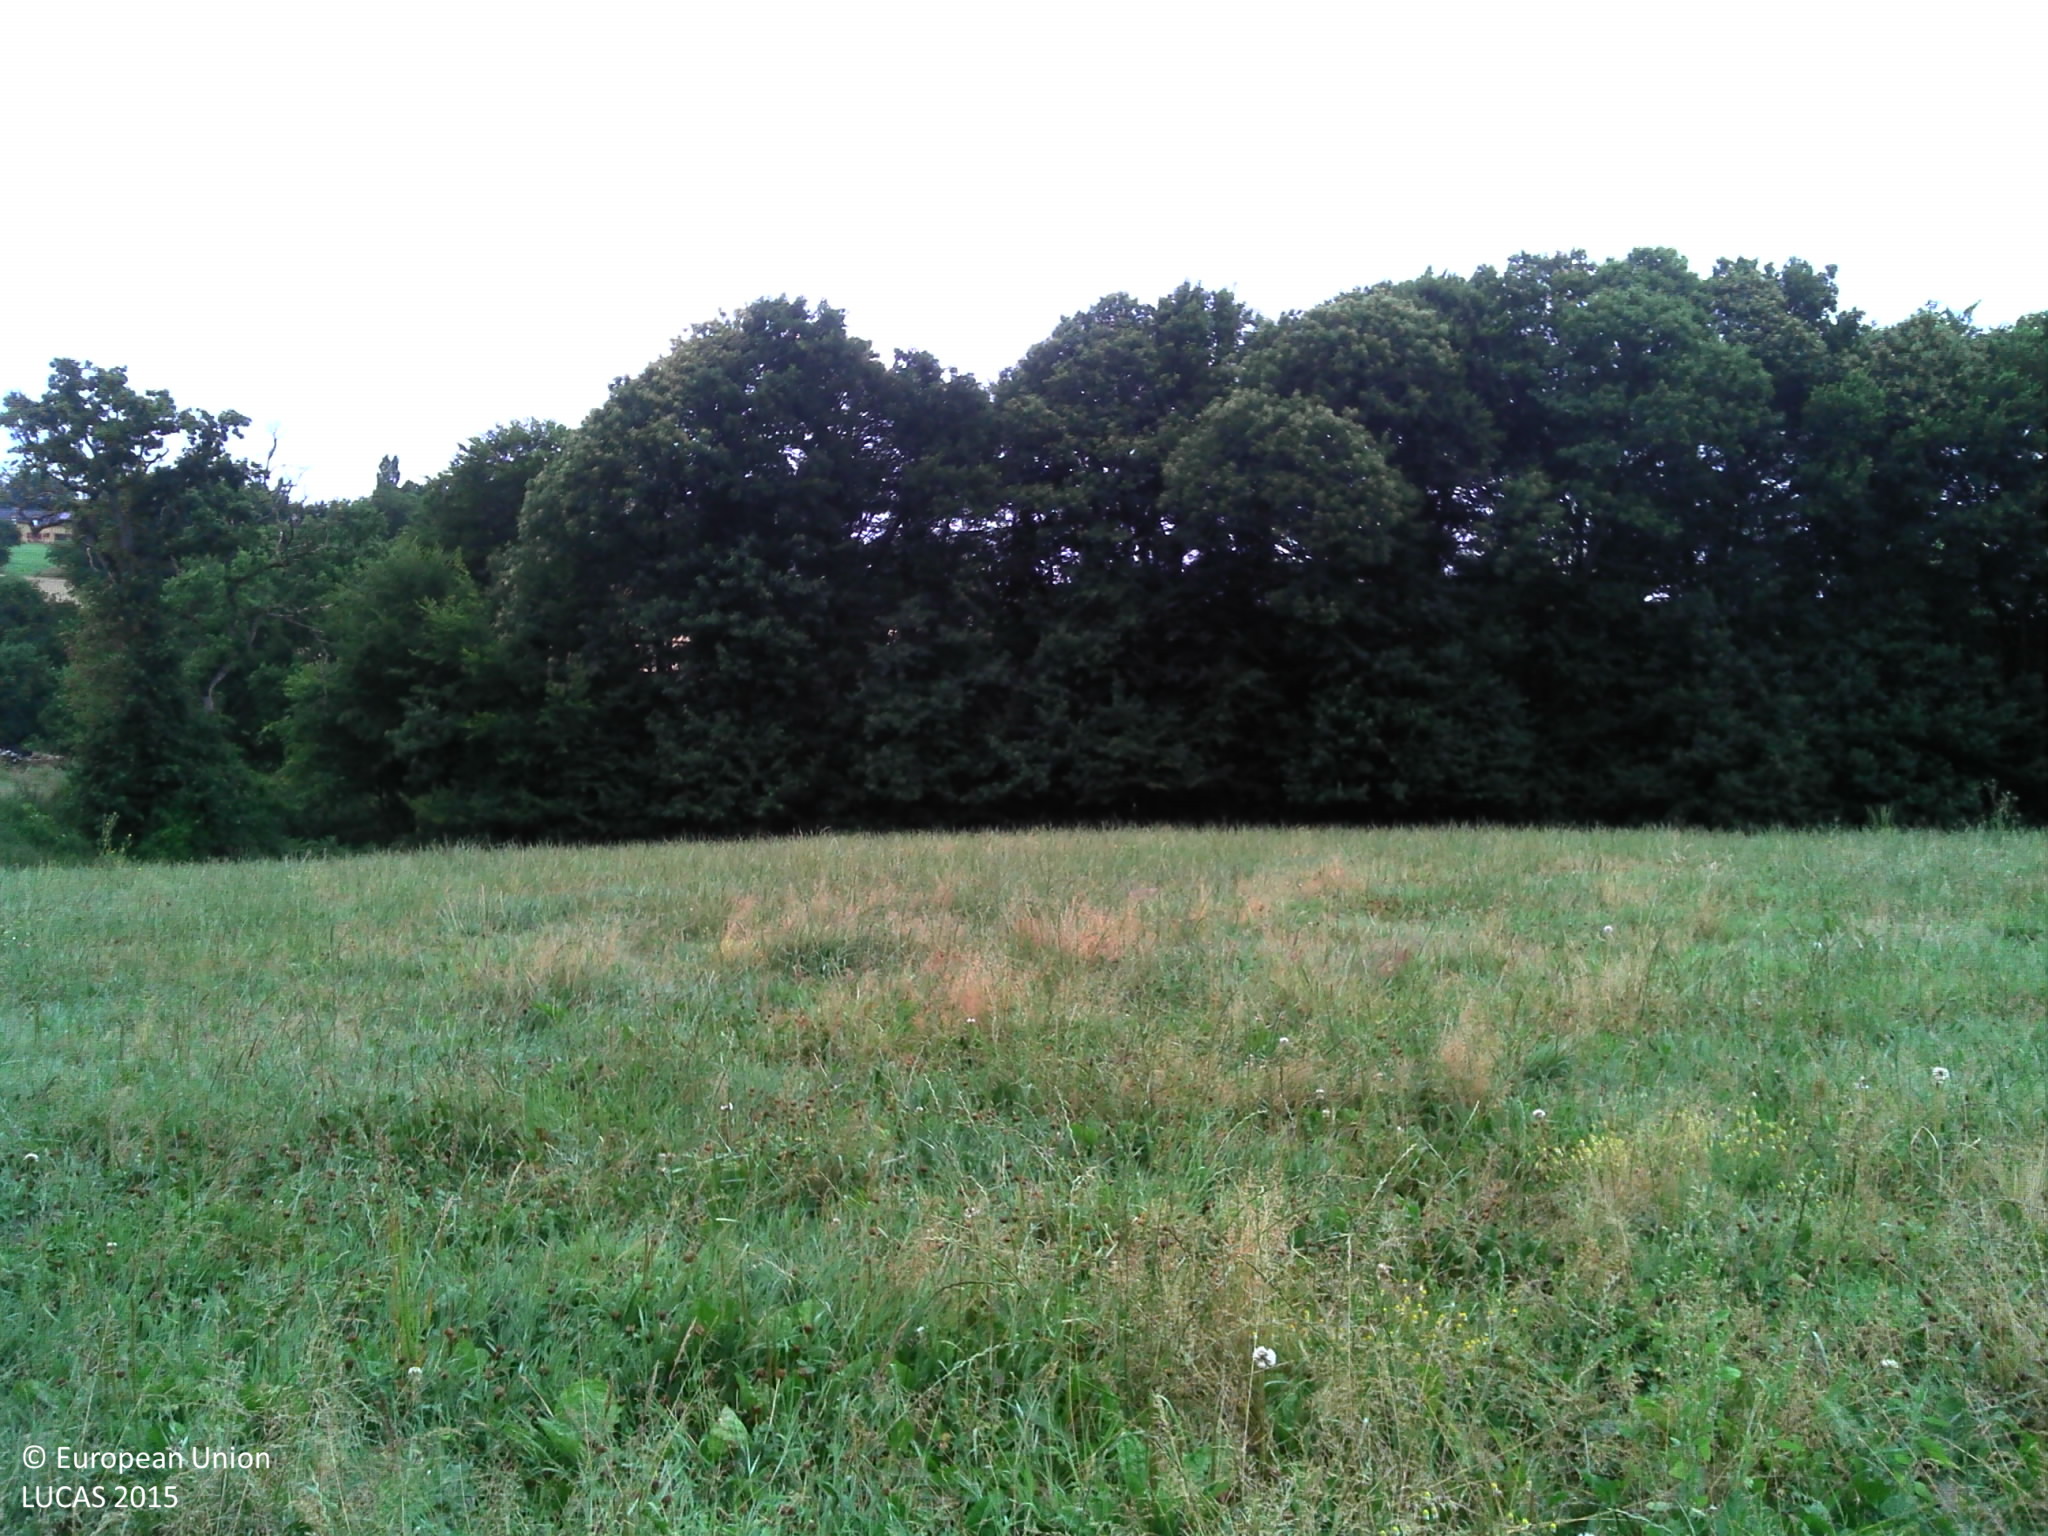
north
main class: Grassland
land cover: Grassland without tree/shrub cover
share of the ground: > 75 %
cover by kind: herbaceous plants 100 %
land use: Agriculture (excluding fallow land and kitchen gardens)
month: July
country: FR
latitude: 48.2555
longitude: -1.6723
